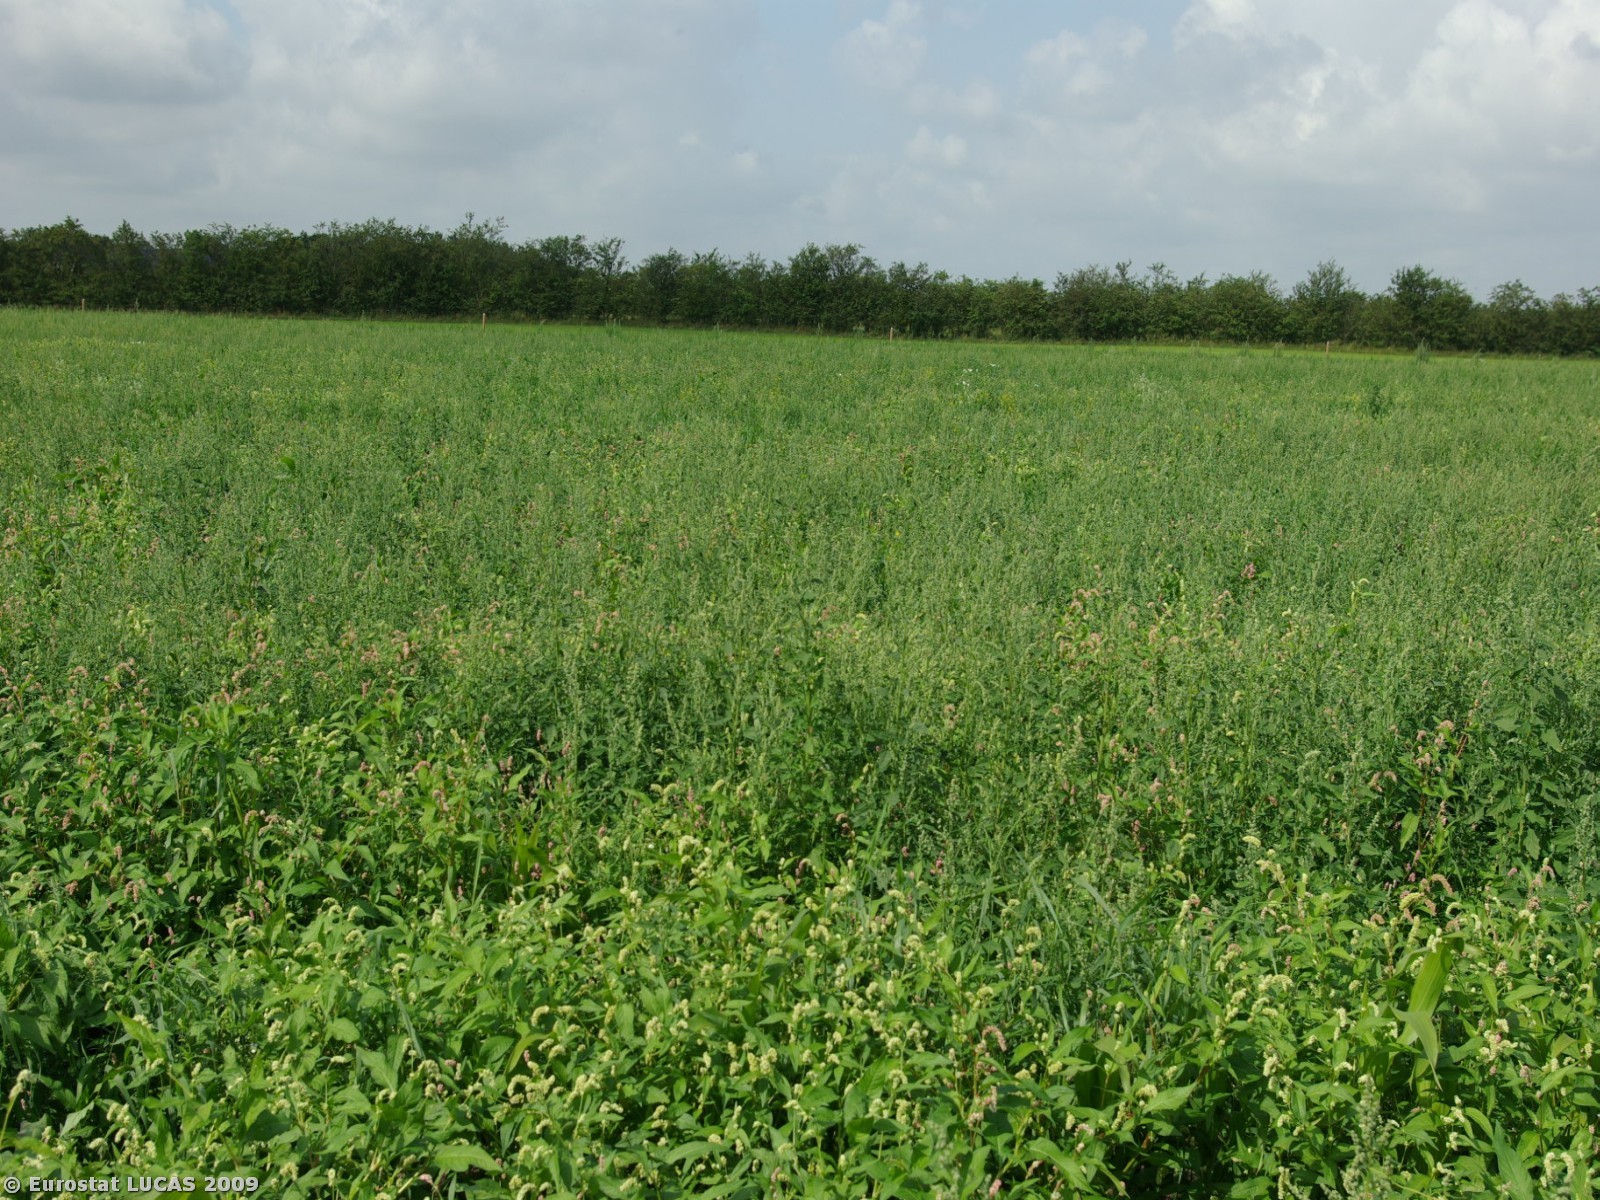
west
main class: Cropland
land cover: Maize
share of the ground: 10 - 25 %
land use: Agriculture (excluding fallow land and kitchen gardens)
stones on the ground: < 10 %
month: July
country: DK
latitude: 54.9096
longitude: 9.2986
